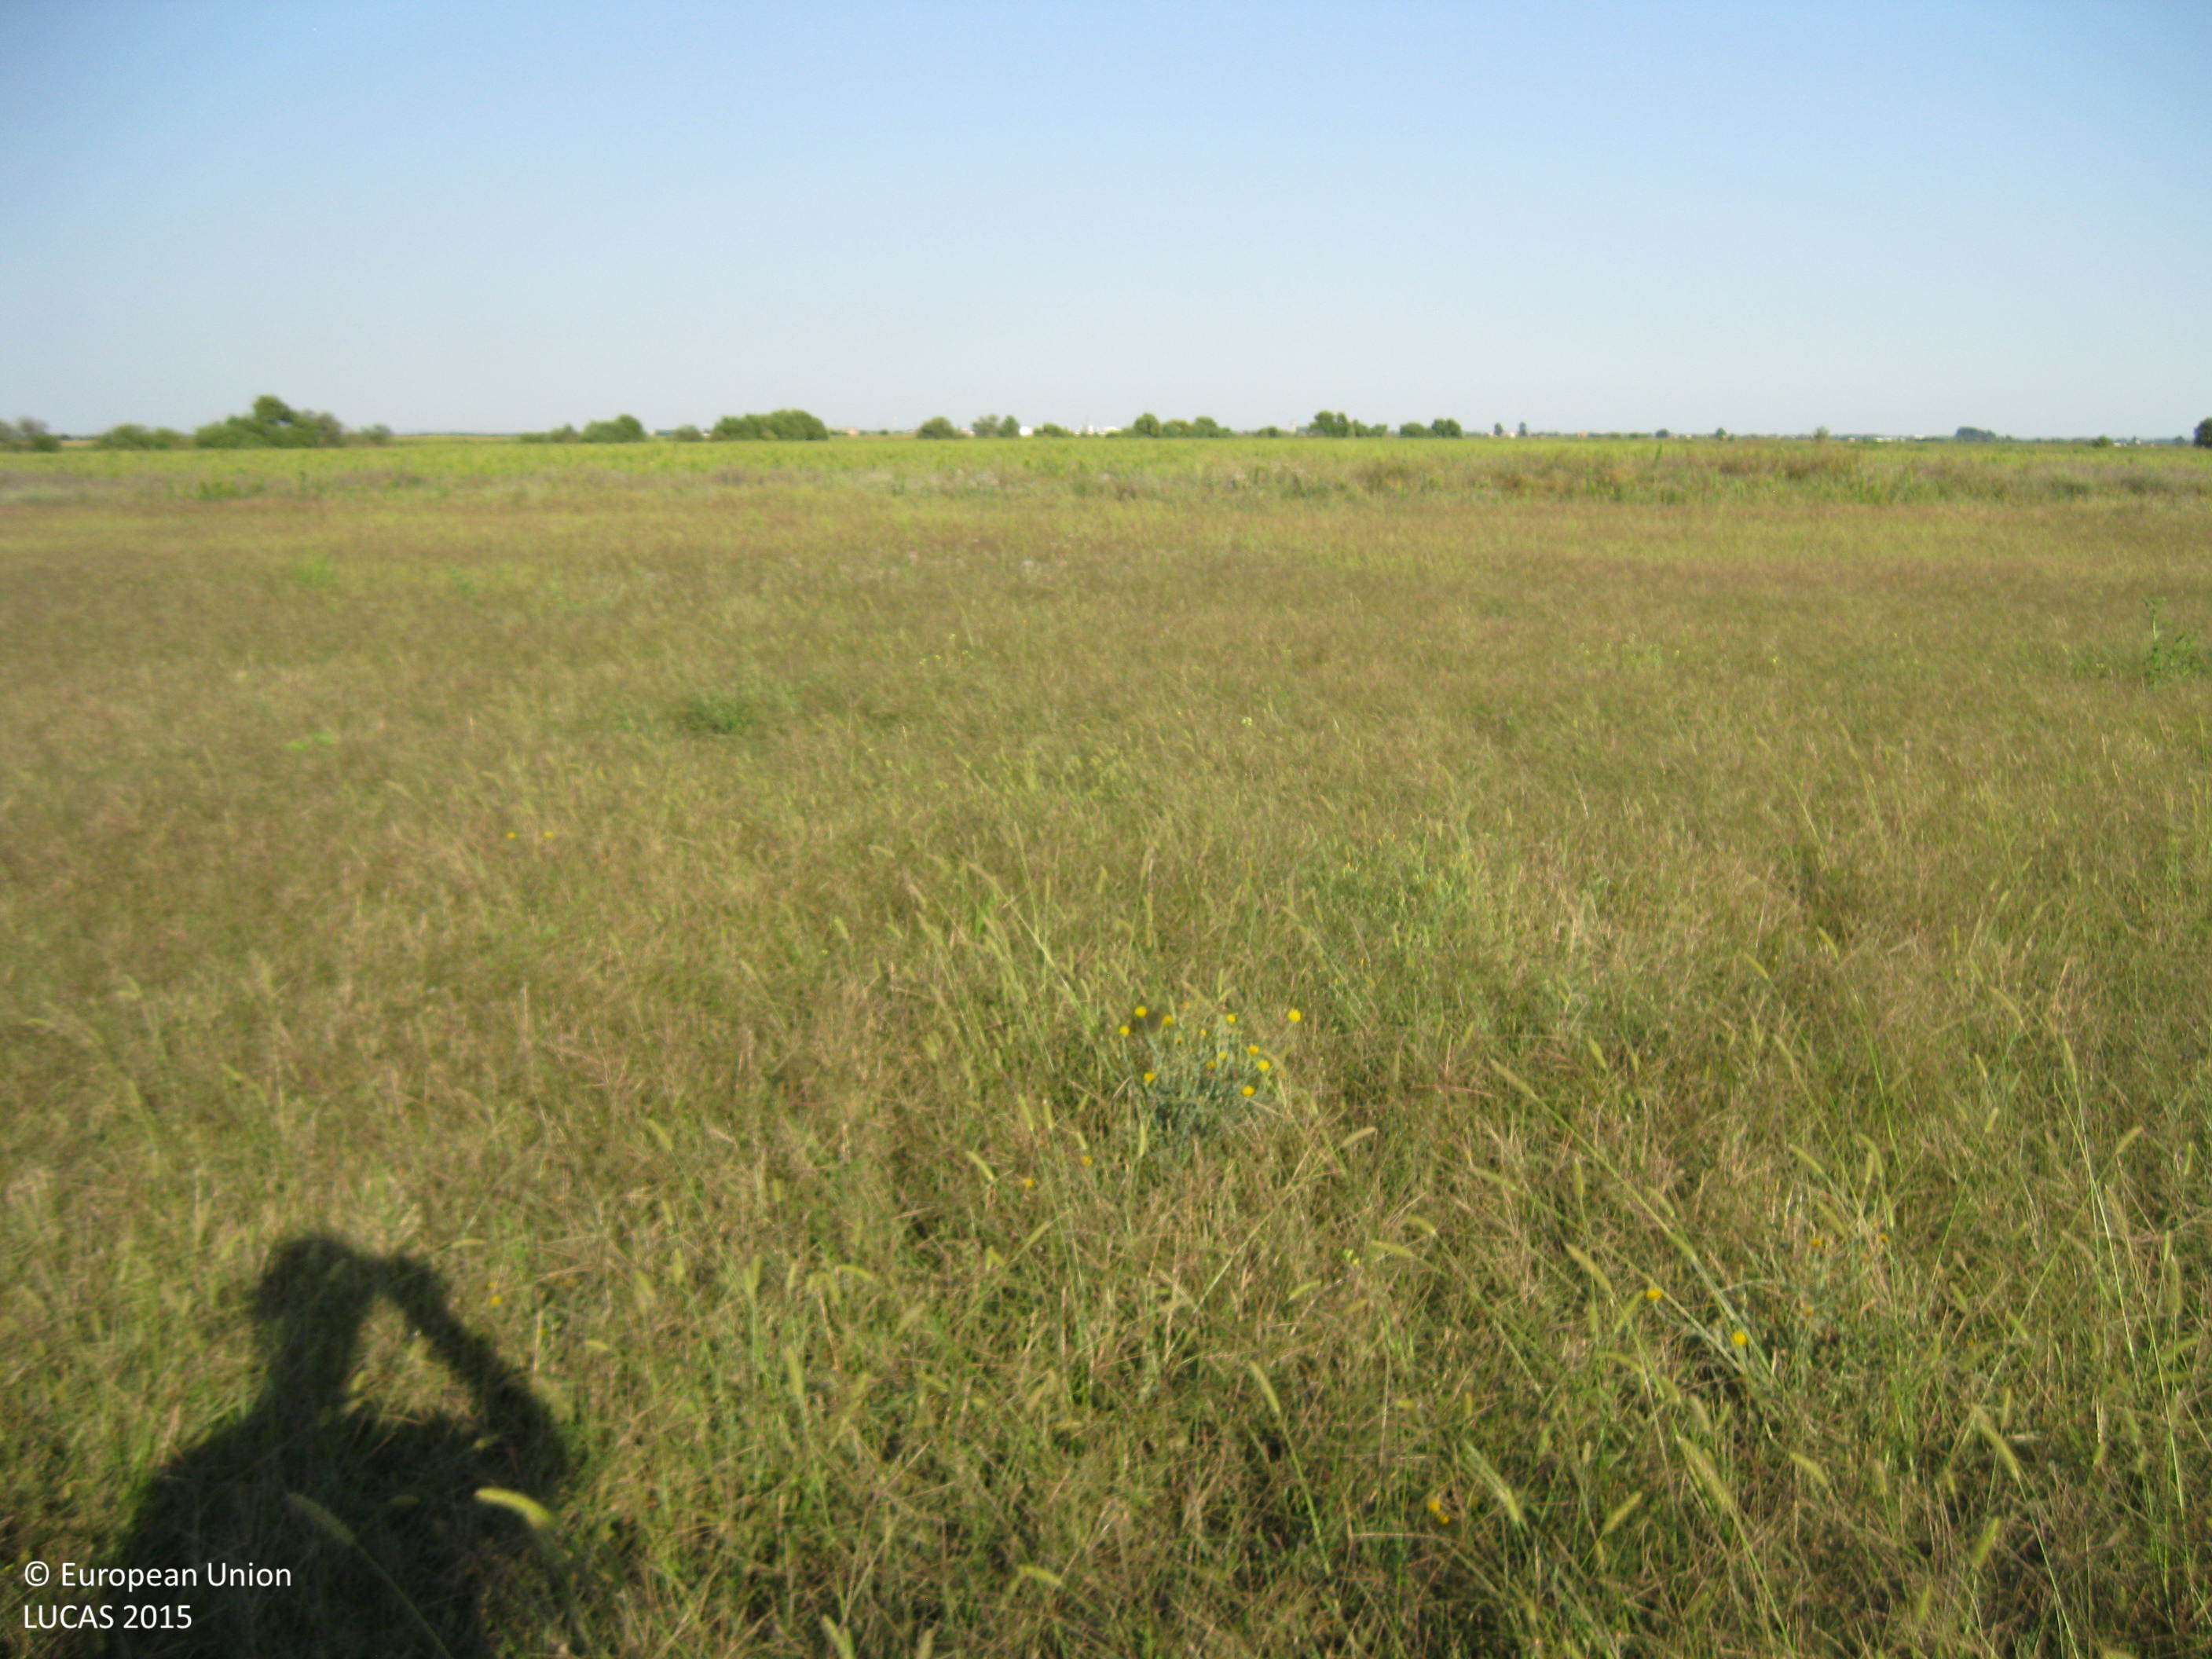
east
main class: Cropland
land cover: Mixed cereals for fodder
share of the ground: 25 - 50 %
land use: Agriculture (excluding fallow land and kitchen gardens)
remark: Harvested field
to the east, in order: Mixed cereals for fodder; Grass margins; Tracks; Grass margins; Other fresh vegetables
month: August
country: BG
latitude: 42.2094
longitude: 24.9915
